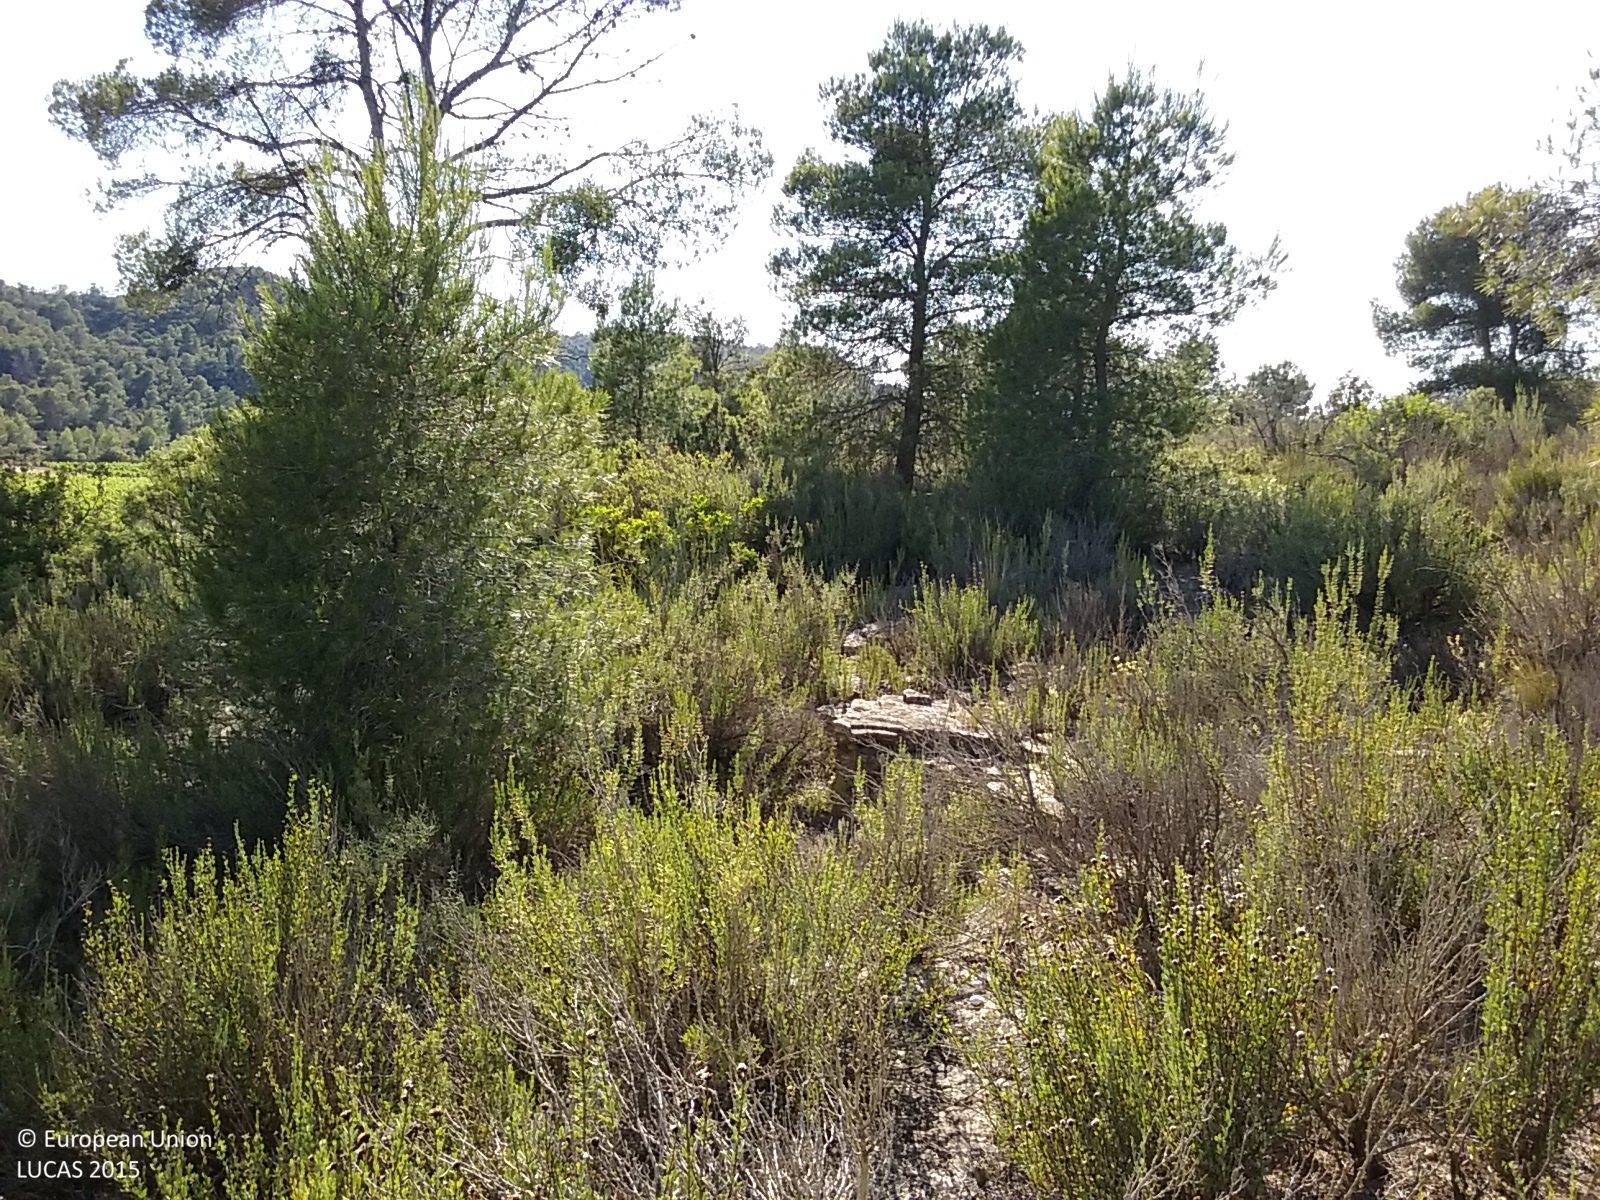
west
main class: Woodland
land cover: Pine dominated coniferous woodland
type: coniferous forest of the mediterranean region
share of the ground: 10 - 25 %
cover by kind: shrubs 65 %, coniferous forest trees 20 %, herbaceous plants 10 %, unconsolidated bare surface 5 %
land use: Semi-natural and natural areas not in use
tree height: > 5 m
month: June
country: ES
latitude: 41.0904
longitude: 0.2402
